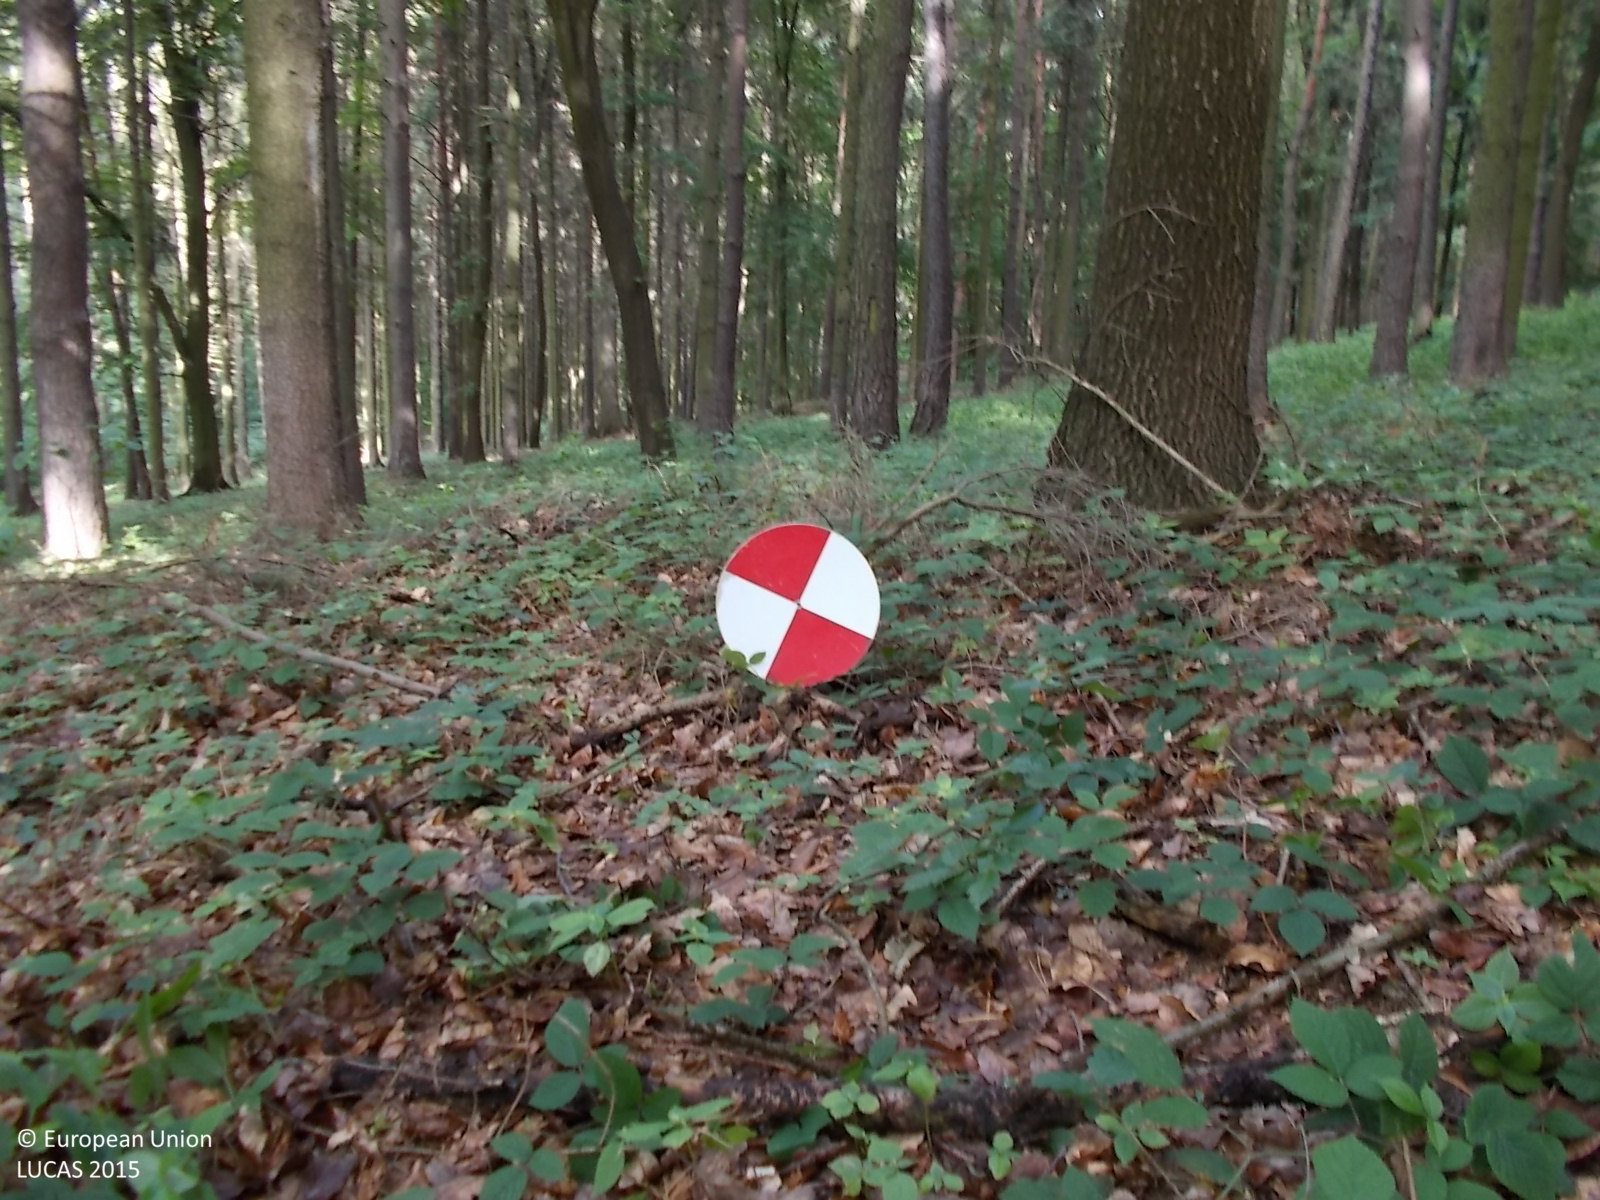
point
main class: Woodland
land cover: Other mixed woodland
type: hemiboreal forest and nemoral coniferous forest and mixed broadleaved-coniferous forest
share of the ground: > 75 %
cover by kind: coniferous forest trees 50 %, broadleaved forest trees 35 %, herbaceous plants 10 %, shrubs 5 %
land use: Forestry
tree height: > 5 m
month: June
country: CZ
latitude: 49.2631
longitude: 17.5839
